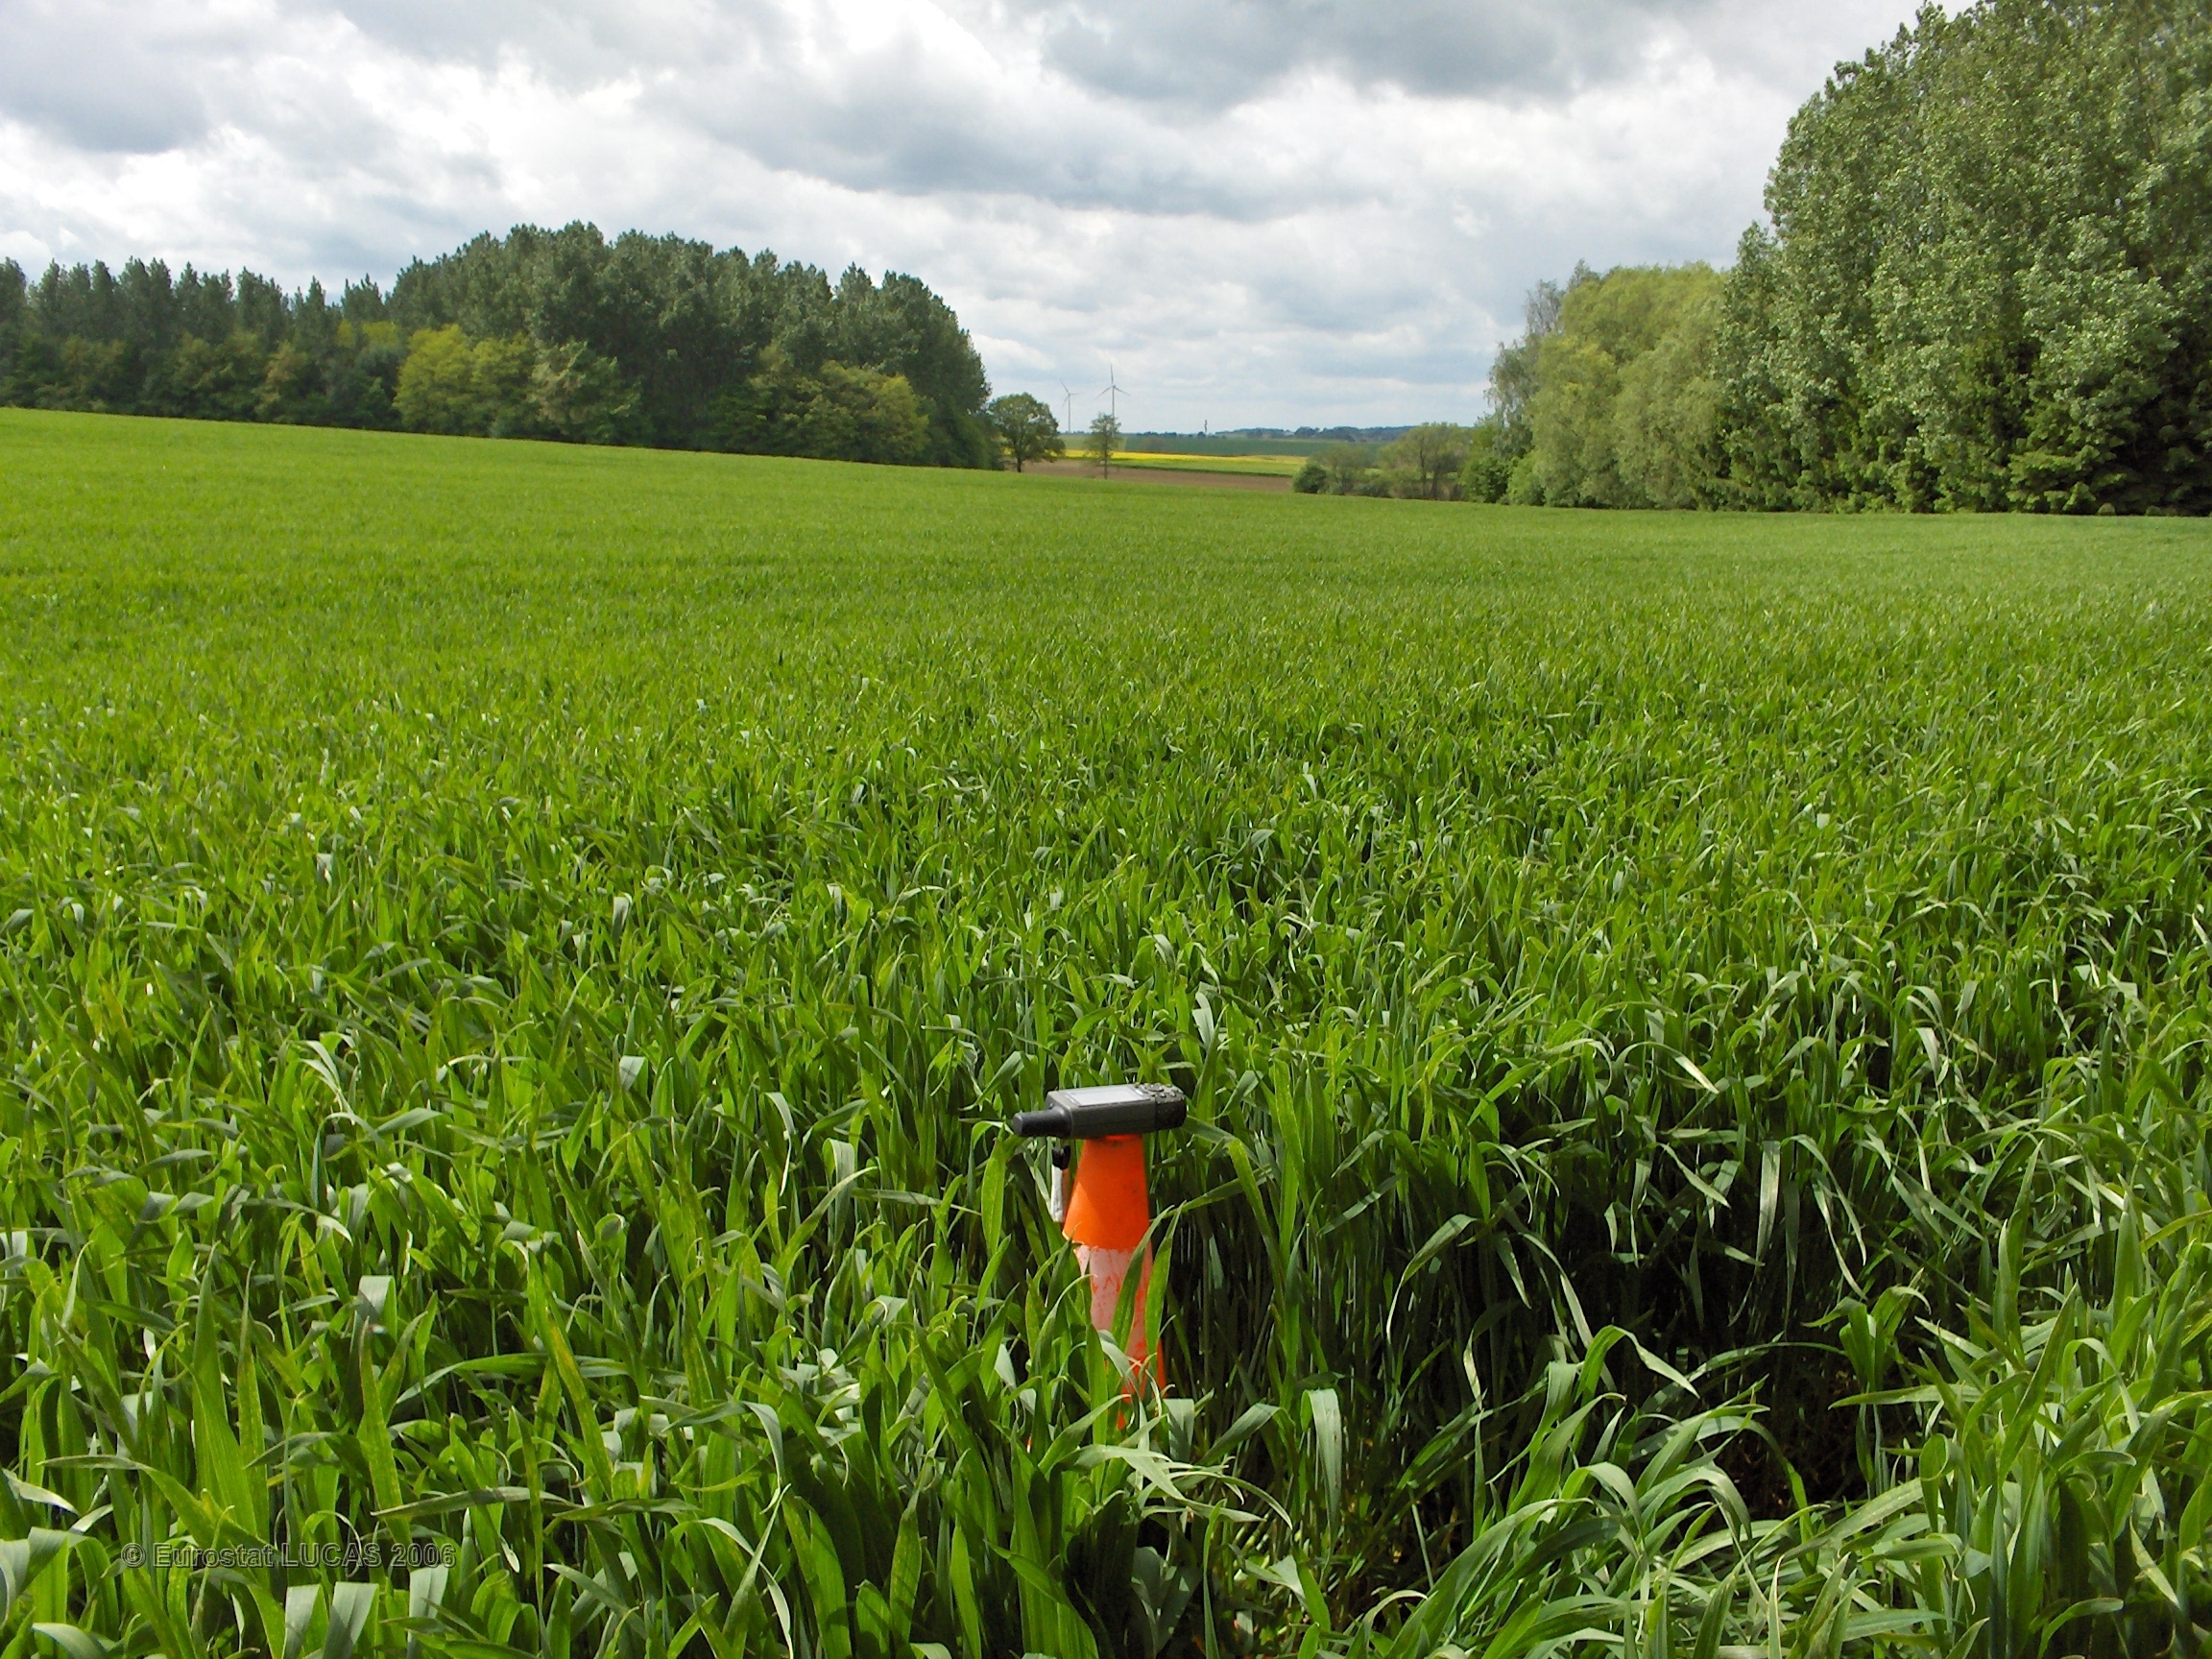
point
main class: Cropland
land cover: Common wheat
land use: Agriculture (excluding fallow land and kitchen gardens)
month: May
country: BE
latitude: 50.3248
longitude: 4.5602
